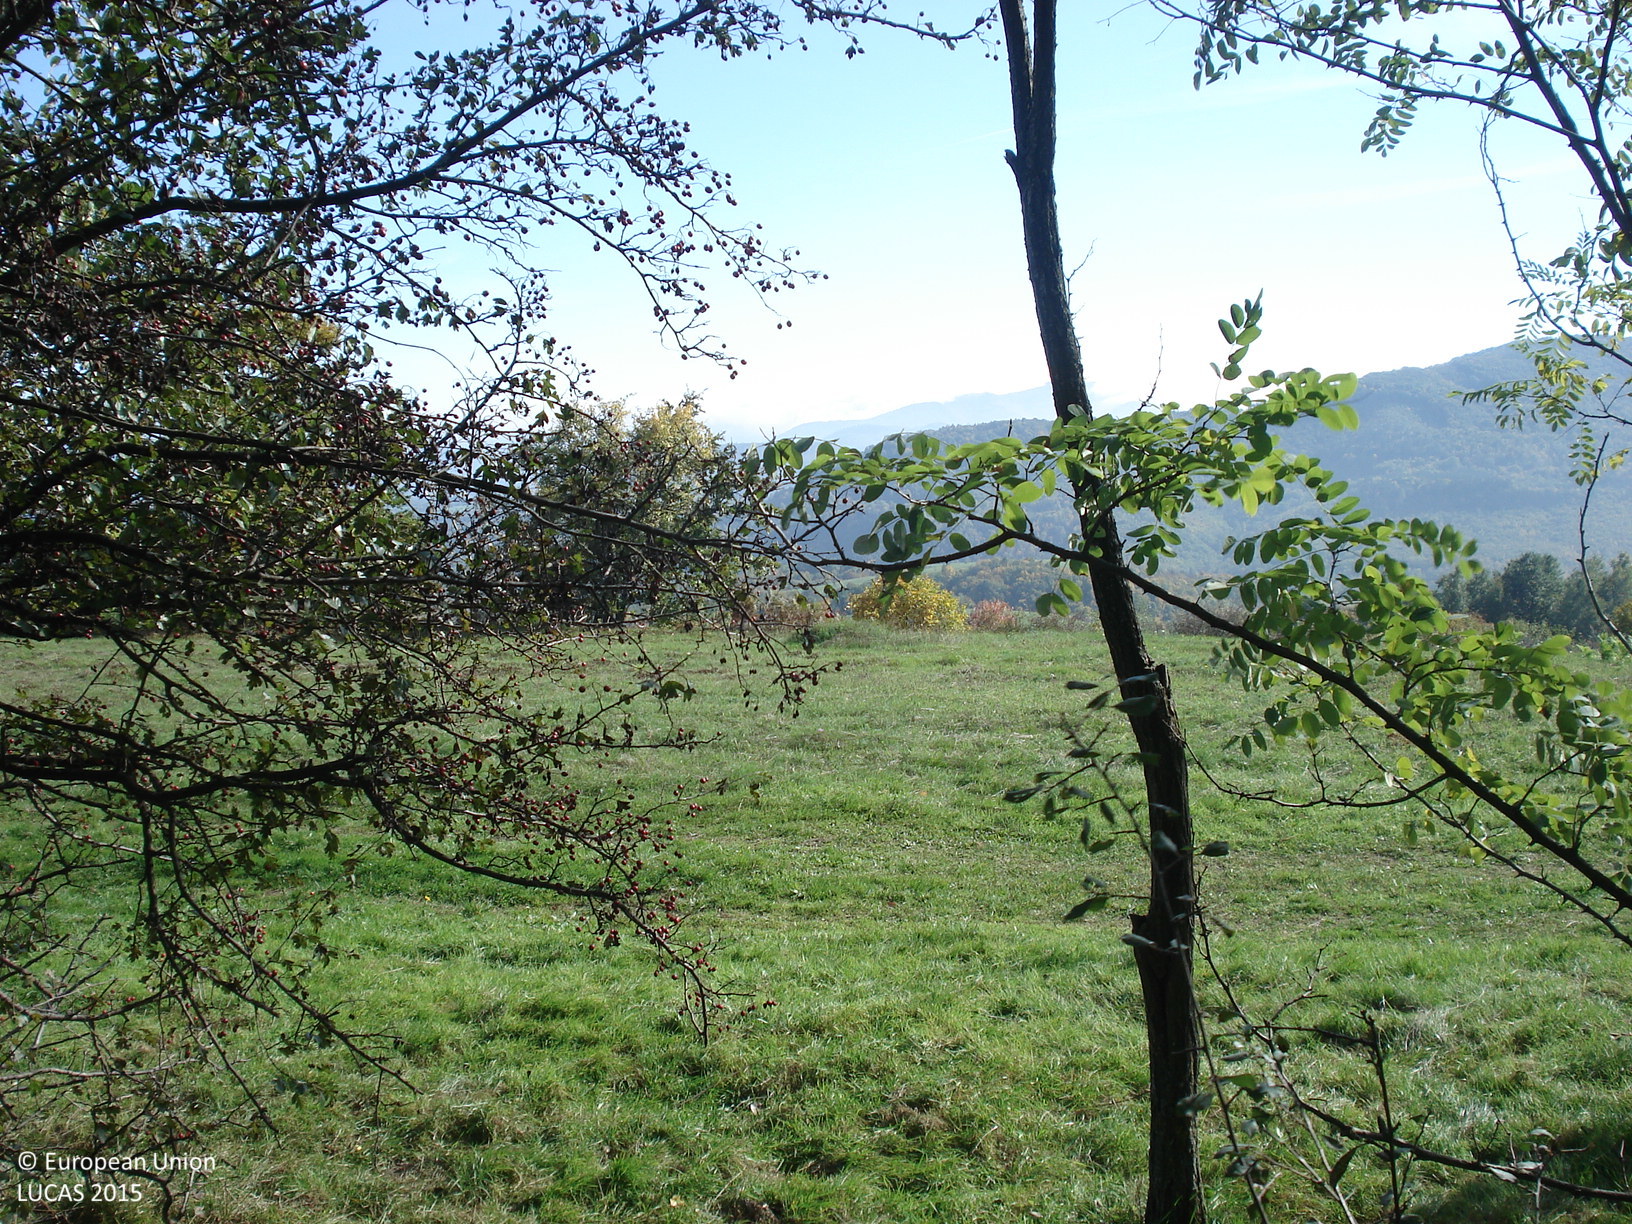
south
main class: Woodland
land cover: Broadleaved woodland
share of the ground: 50 - 75 %
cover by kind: broadleaved forest trees 60 %, herbaceous plants 25 %, shrubs 15 %
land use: Agriculture (excluding fallow land and kitchen gardens)
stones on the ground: < 10 %
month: October
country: BG
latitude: 42.9220
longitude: 26.0755
